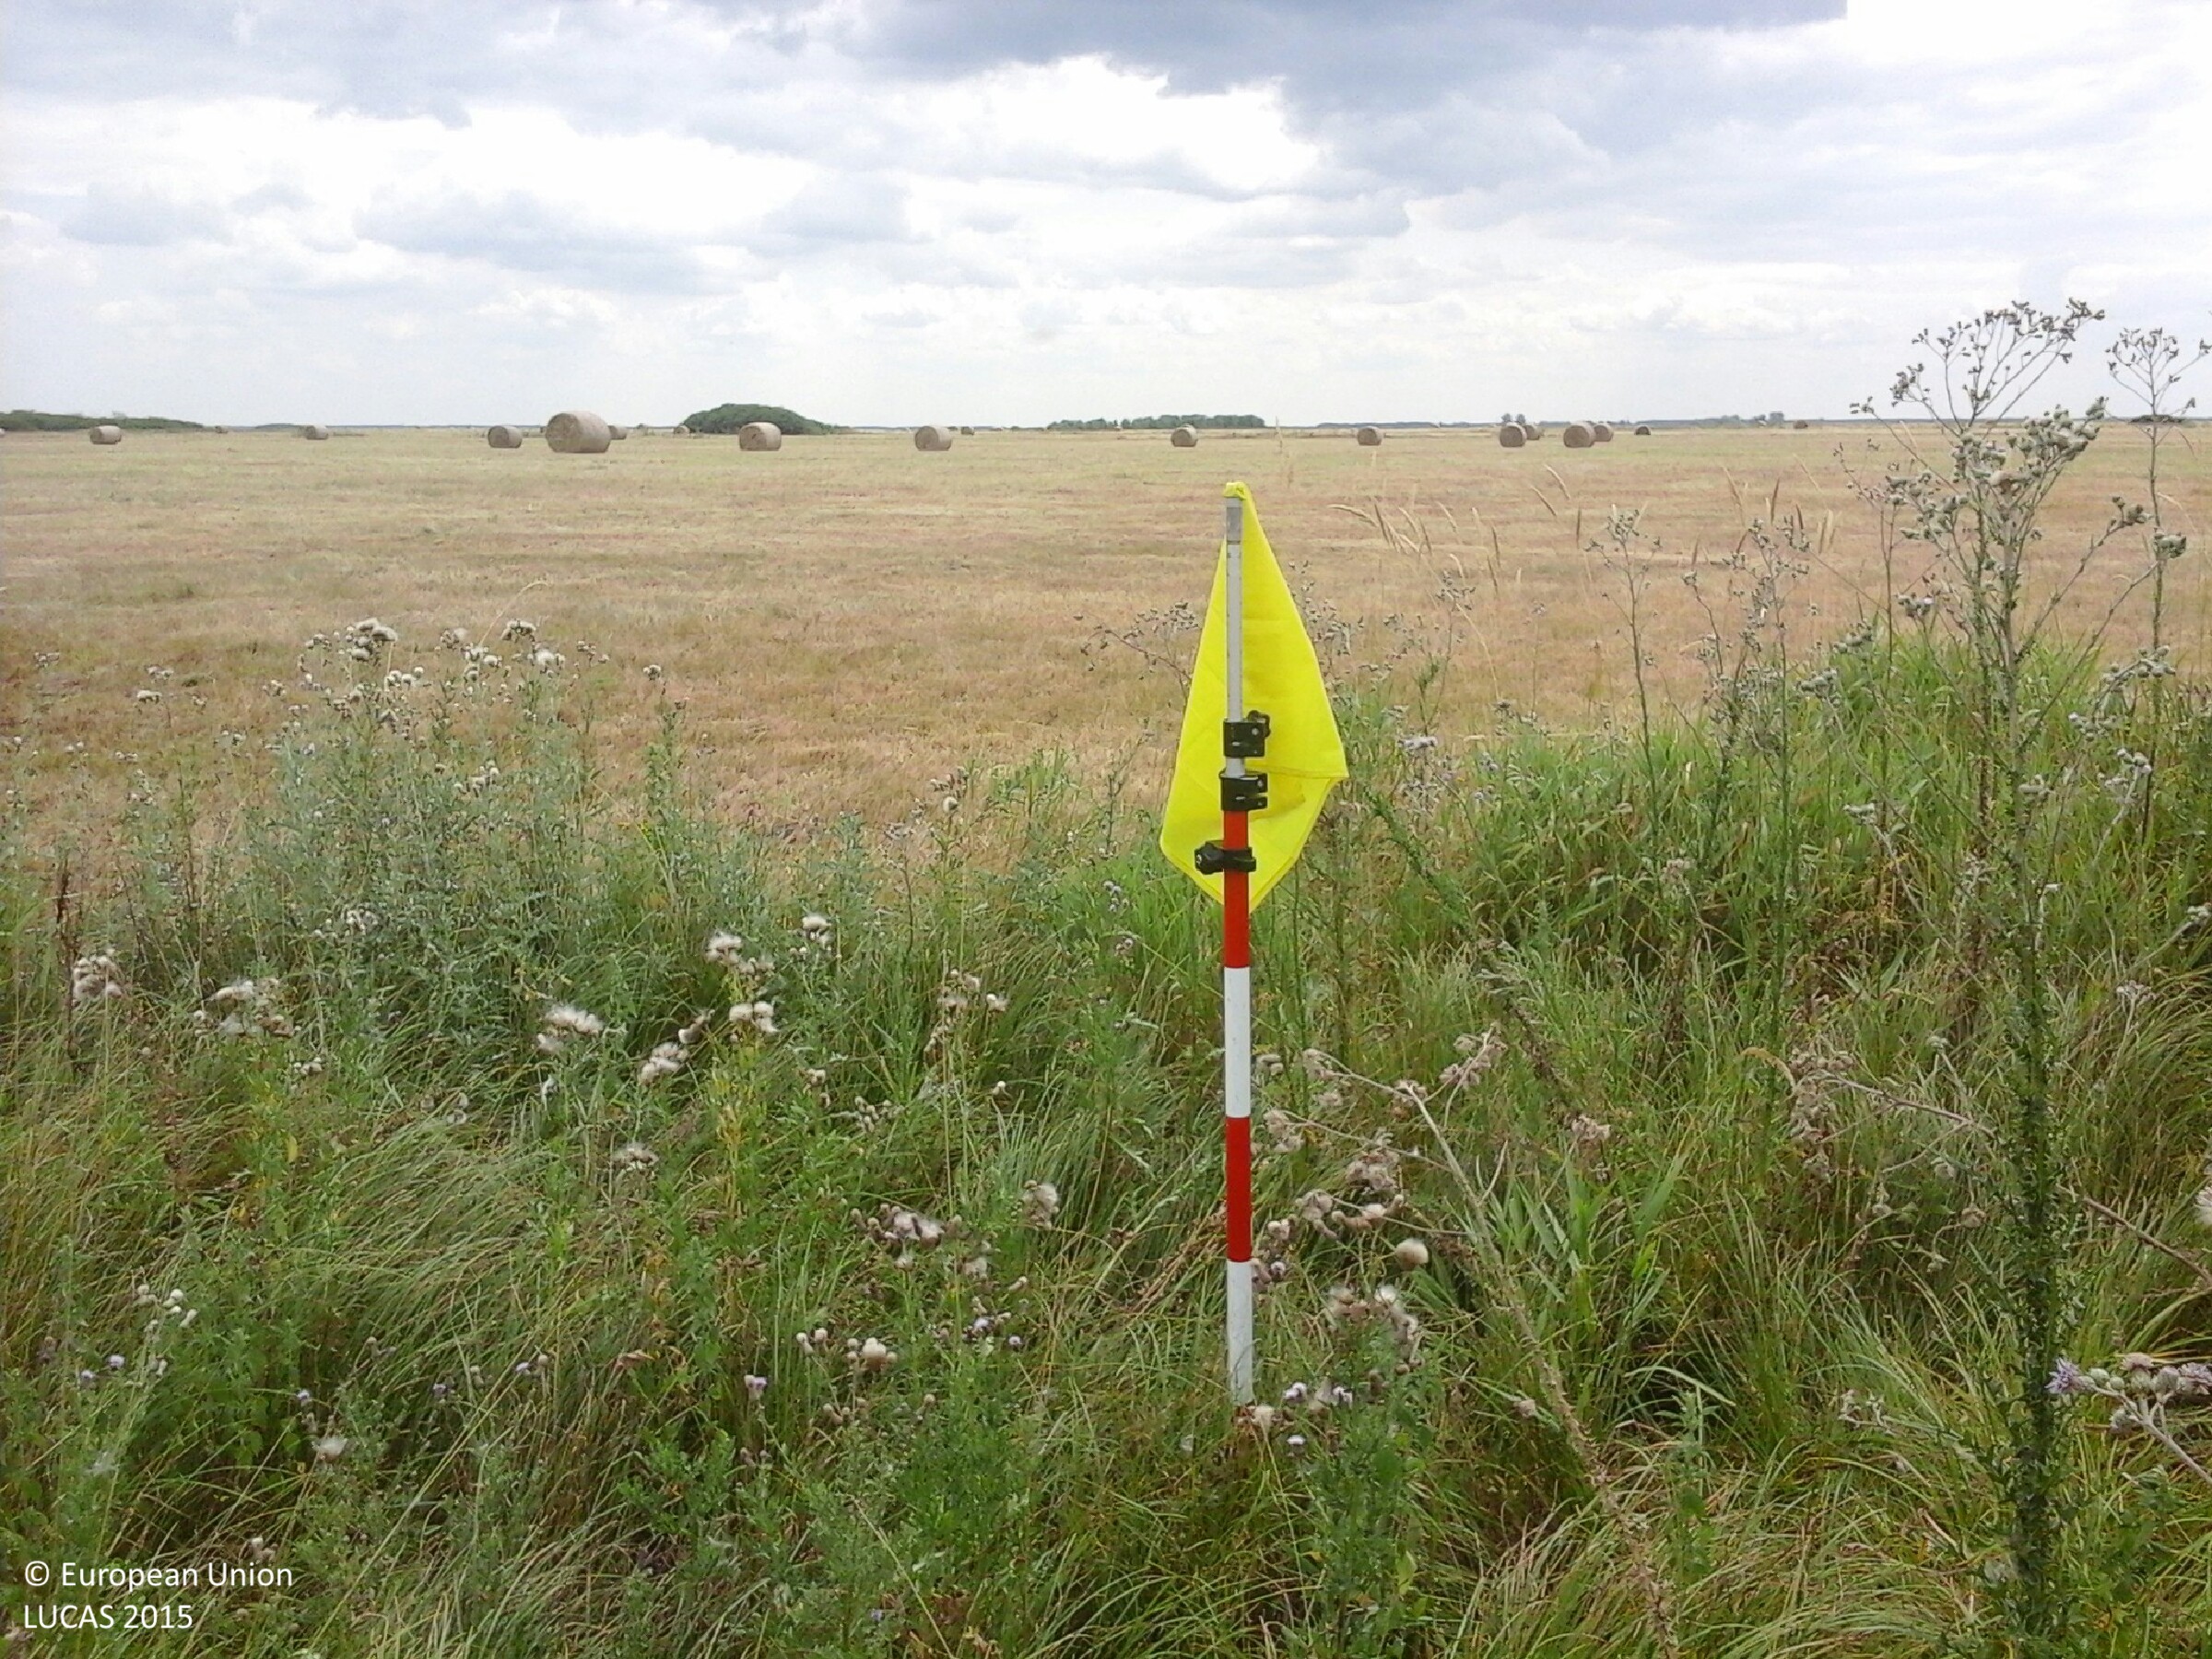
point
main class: Grassland
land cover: Grassland without tree/shrub cover
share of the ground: > 75 %
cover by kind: herbaceous plants 100 %
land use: Agriculture (excluding fallow land and kitchen gardens)
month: July
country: HU
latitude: 47.7788
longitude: 20.8327
